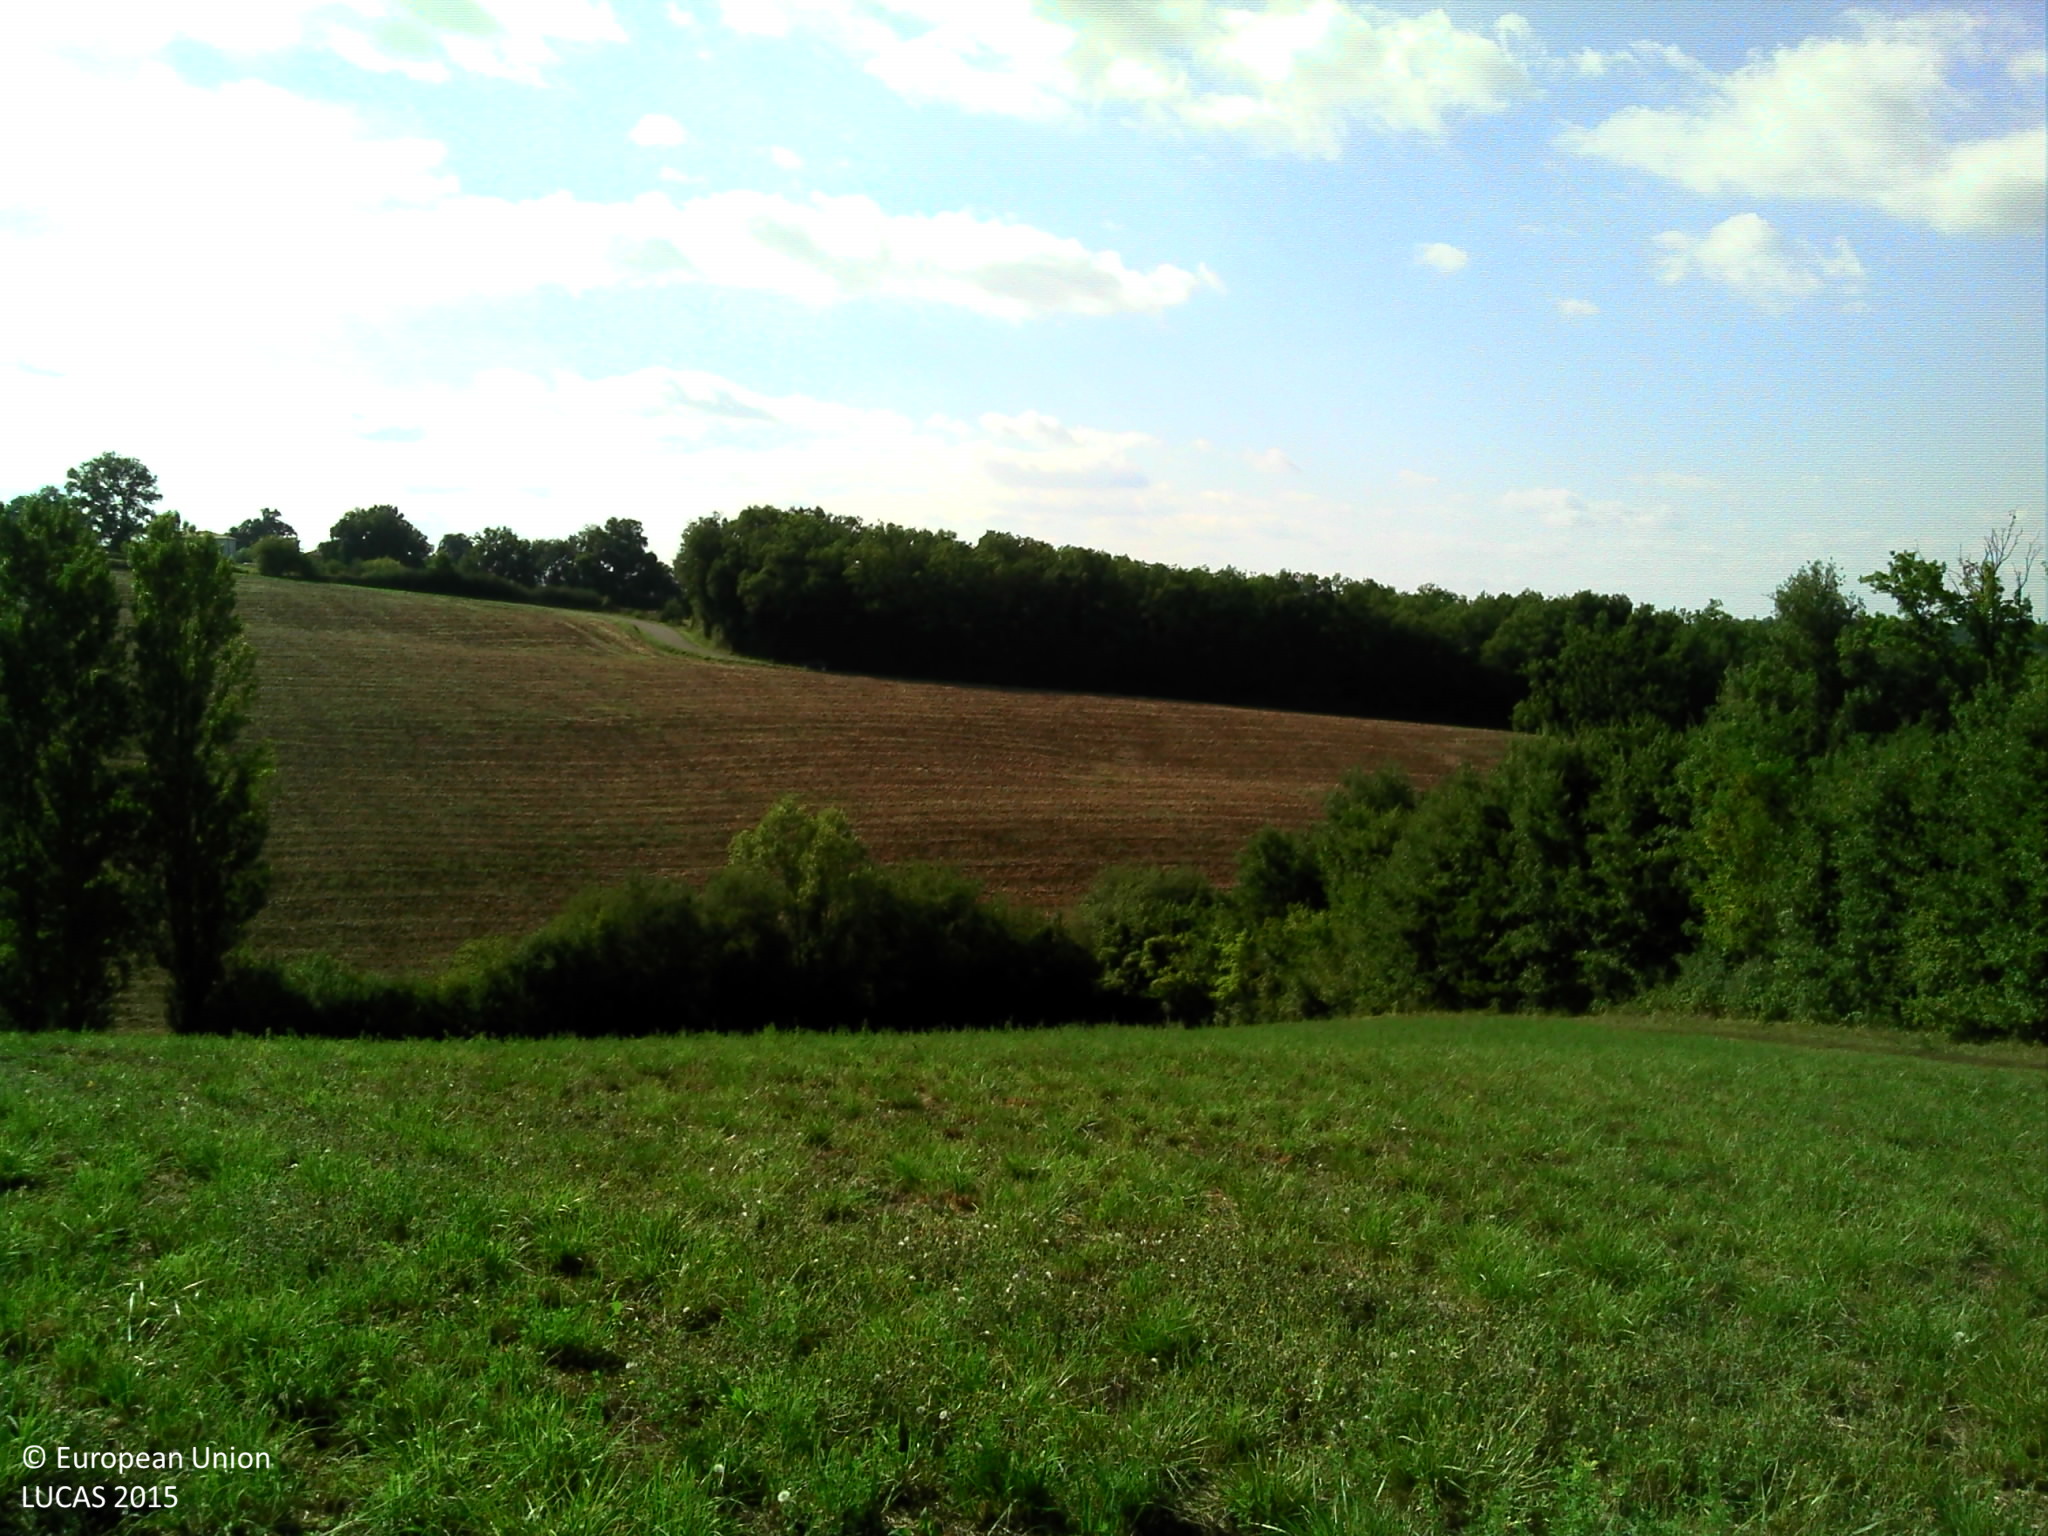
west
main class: Cropland
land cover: Temporary grasslands
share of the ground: > 75 %
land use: Agriculture (excluding fallow land and kitchen gardens)
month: August
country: FR
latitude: 43.9324
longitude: 1.5432
